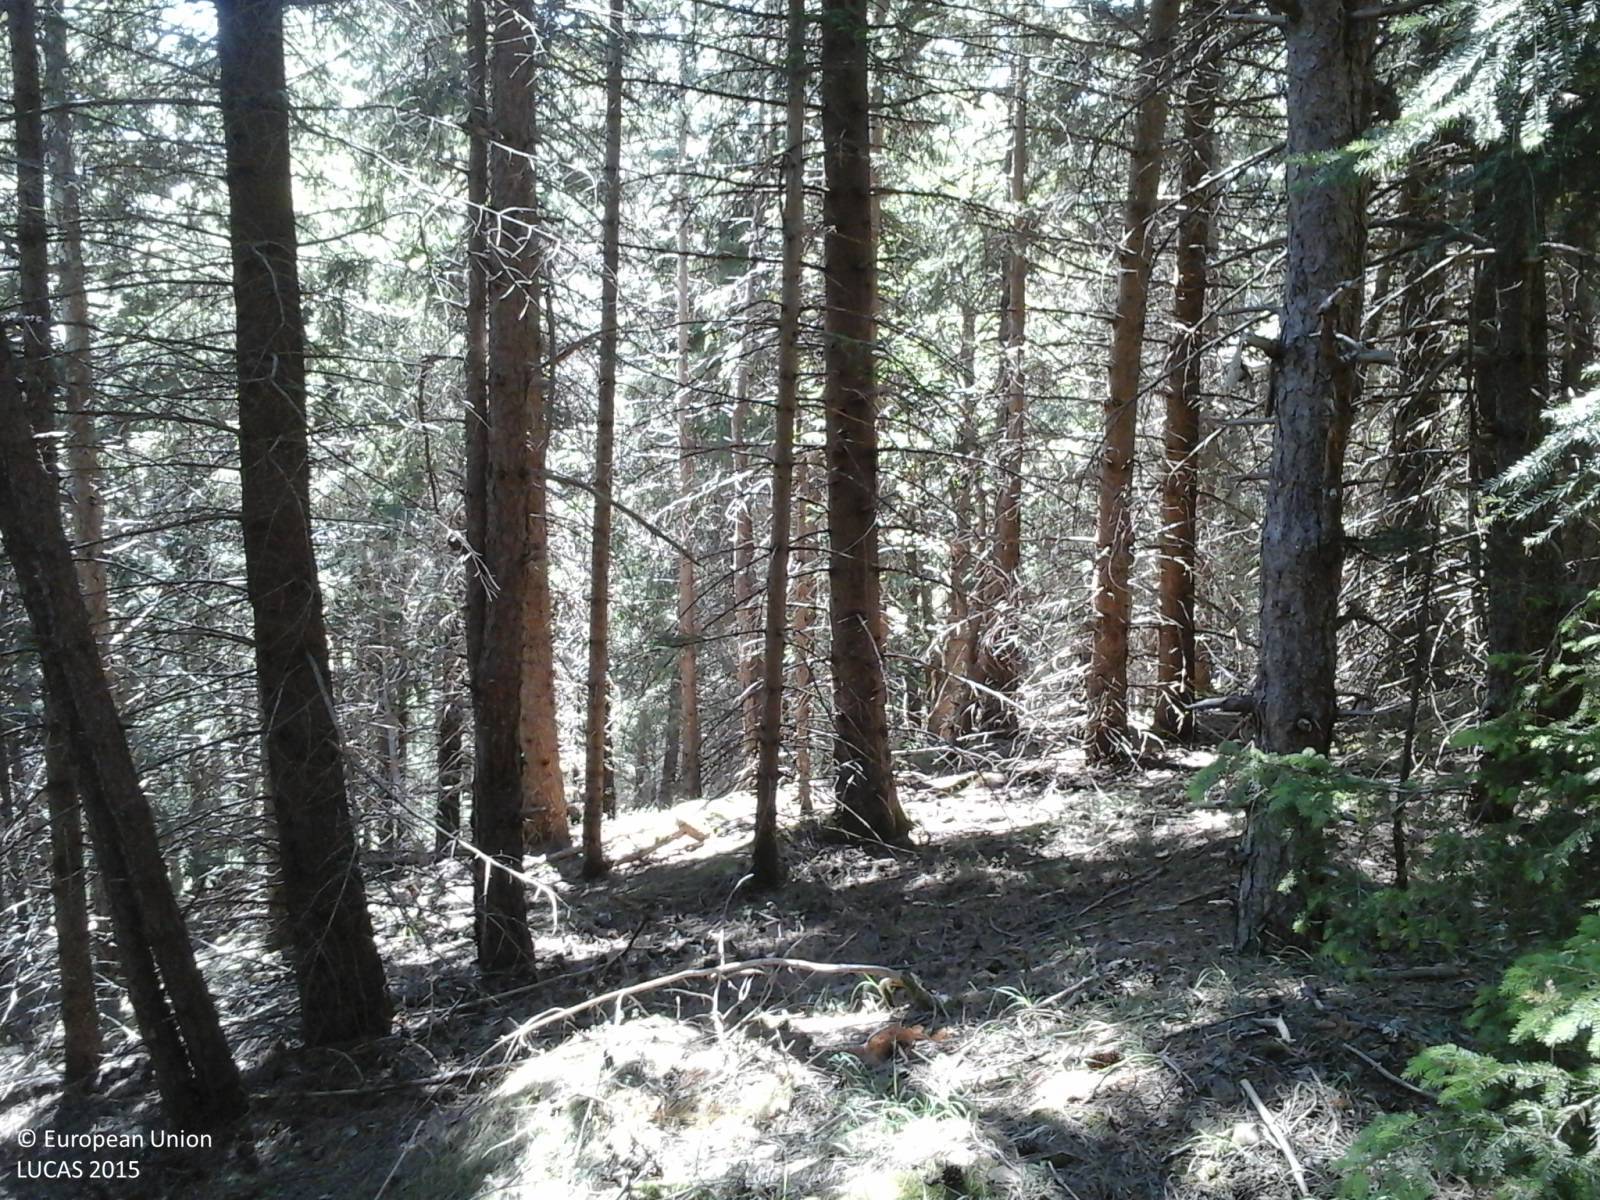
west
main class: Woodland
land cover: Other coniferous woodland
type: coniferous forest of the mediterranean region
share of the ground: > 75 %
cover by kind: coniferous forest trees 100 %
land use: Forestry
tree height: > 5 m
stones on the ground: 10 - 25 %
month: July
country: IT
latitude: 42.5644
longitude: 13.2909
